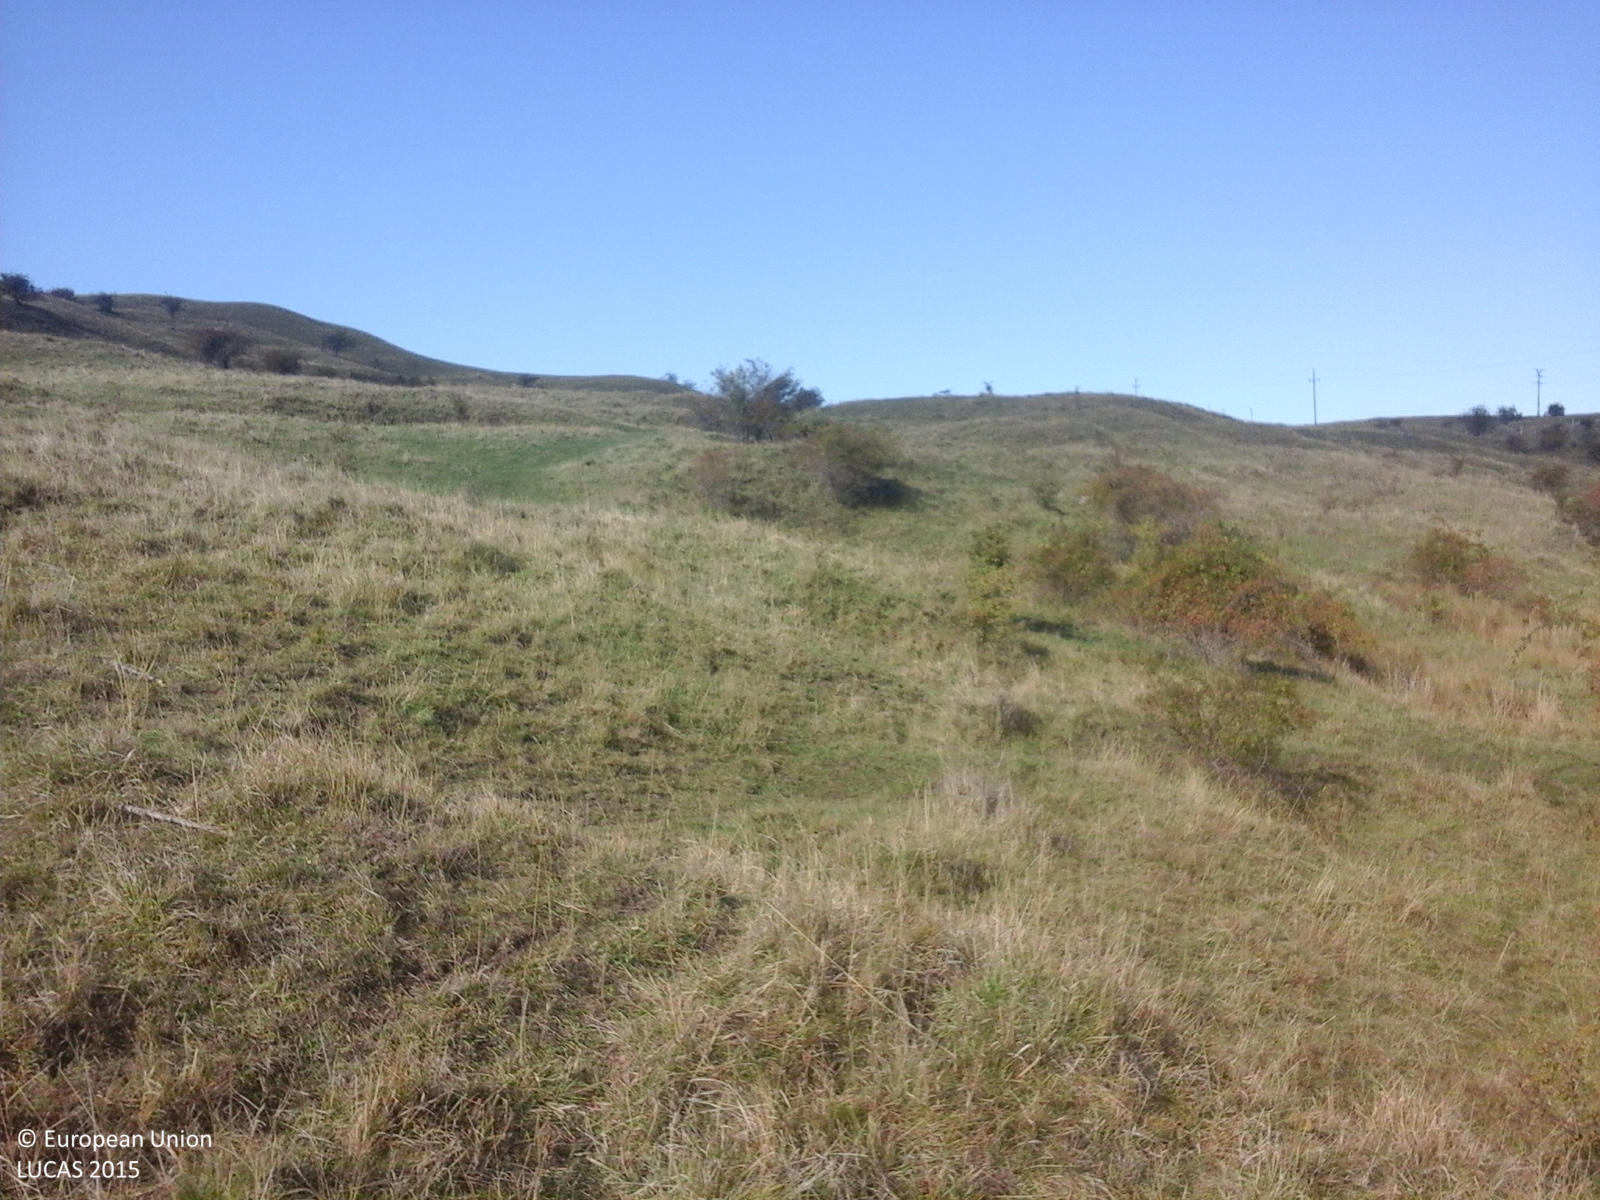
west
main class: Grassland
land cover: Grassland without tree/shrub cover
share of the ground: > 75 %
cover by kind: herbaceous plants 100 %
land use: Agriculture (excluding fallow land and kitchen gardens)
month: October
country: RO
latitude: 45.1949
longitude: 25.1229
